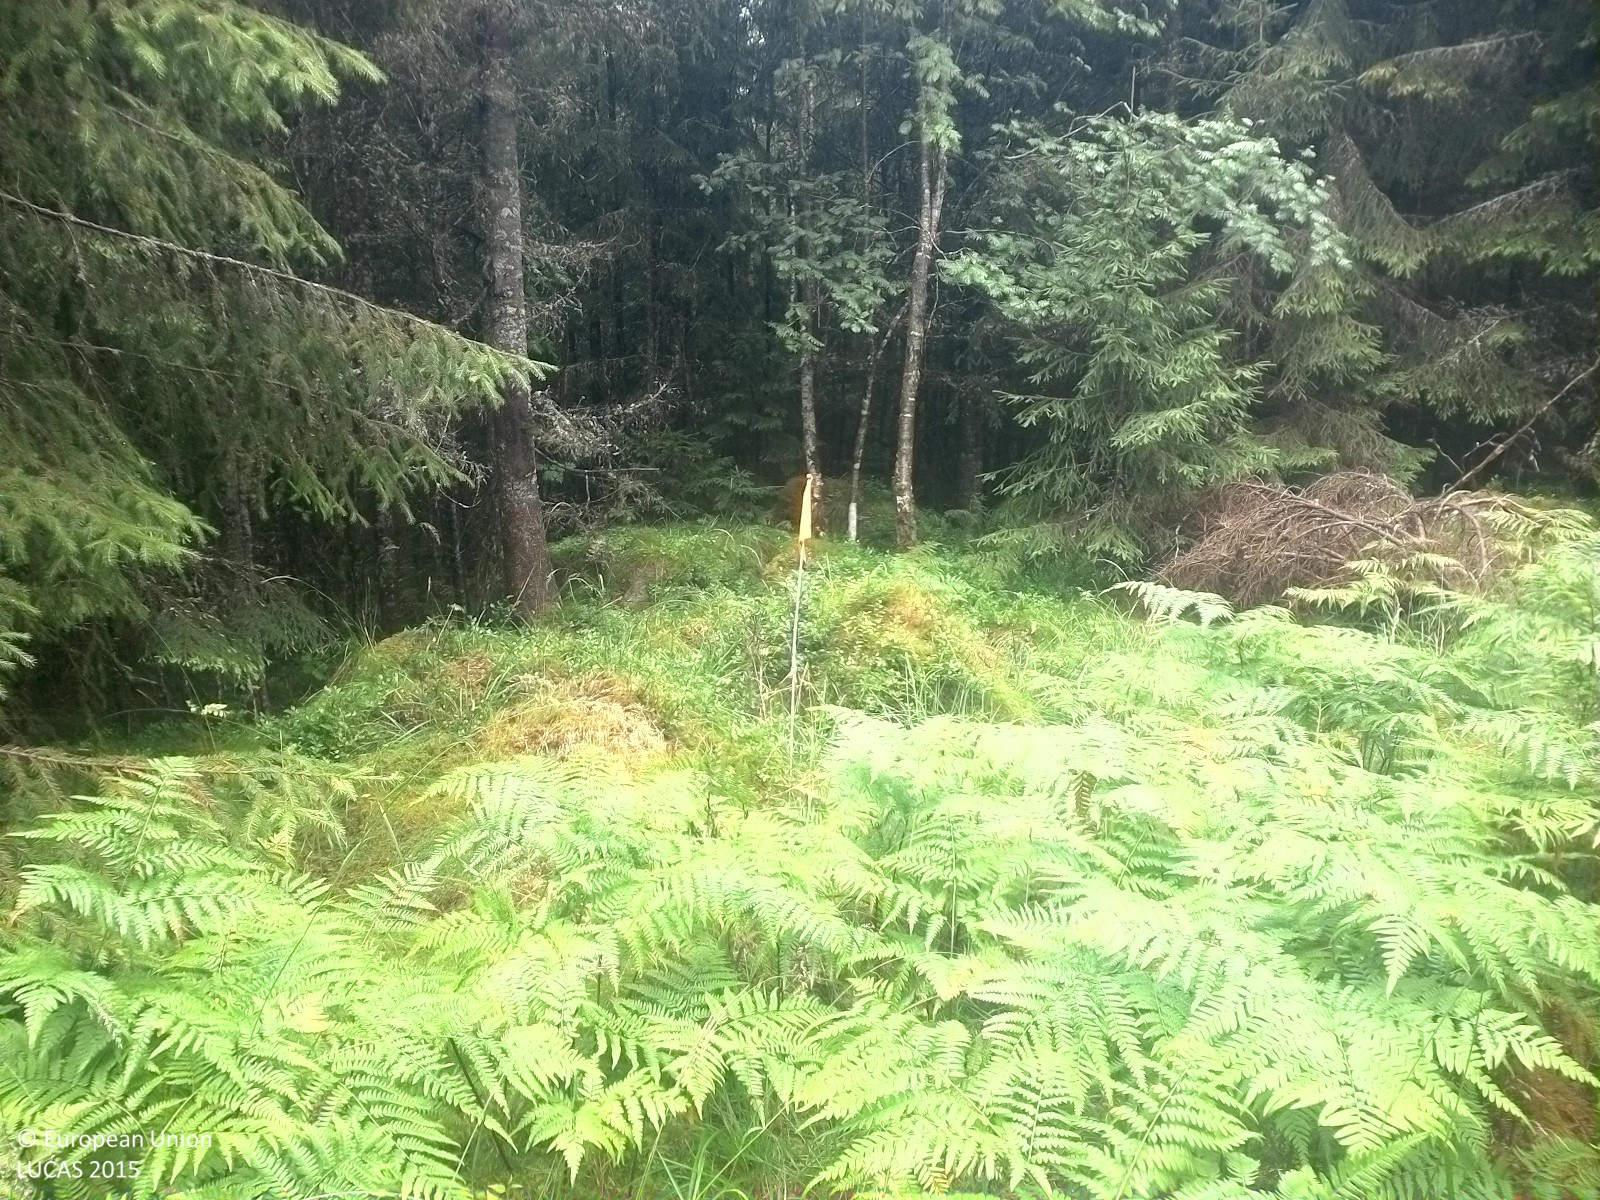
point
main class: Woodland
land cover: Spruce dominated mixed woodland
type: boreal forest
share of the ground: 25 - 50 %
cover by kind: herbaceous plants 55 %, coniferous forest trees 20 %, broadleaved forest trees 15 %, lichens and mosses 10 %
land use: Forestry
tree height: > 5 m
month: July
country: SE
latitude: 58.8463
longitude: 15.0359
